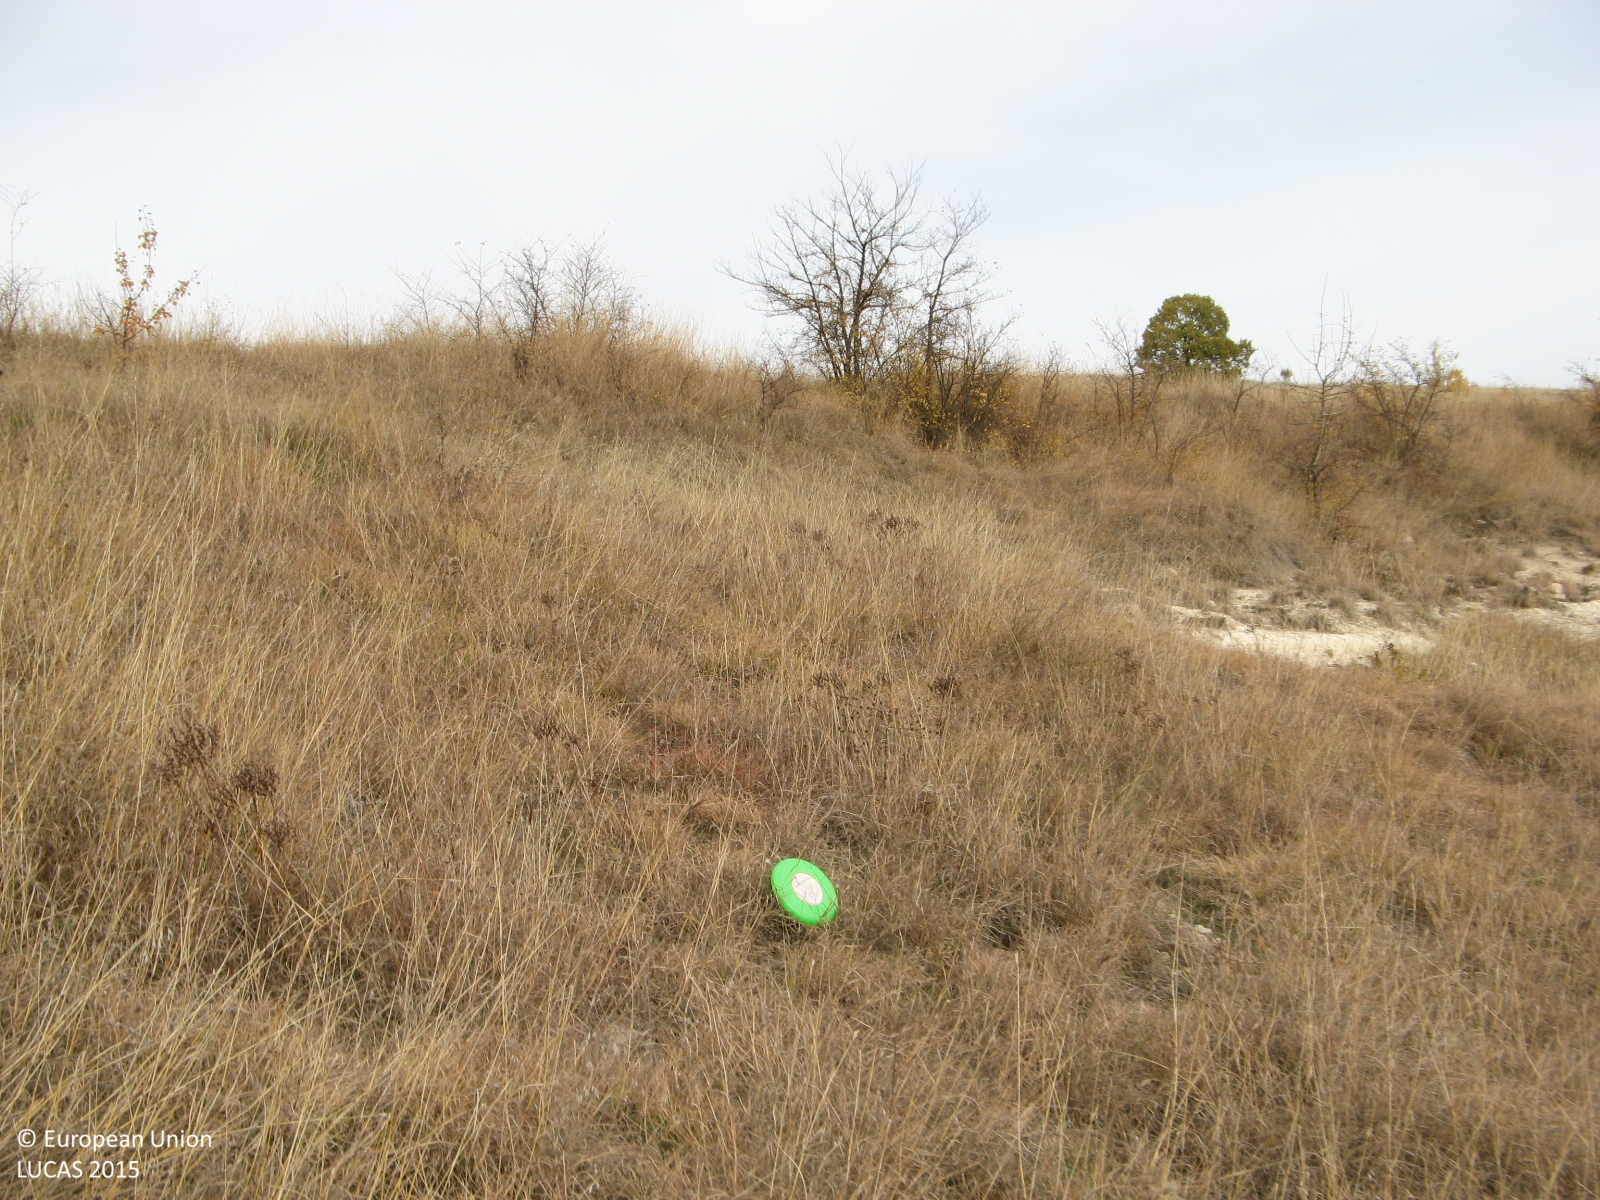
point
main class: Grassland
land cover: Grassland without tree/shrub cover
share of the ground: > 75 %
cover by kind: herbaceous plants 95 %, unconsolidated bare surface 5 %
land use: Semi-natural and natural areas not in use
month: November
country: BG
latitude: 41.9864
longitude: 25.1323
